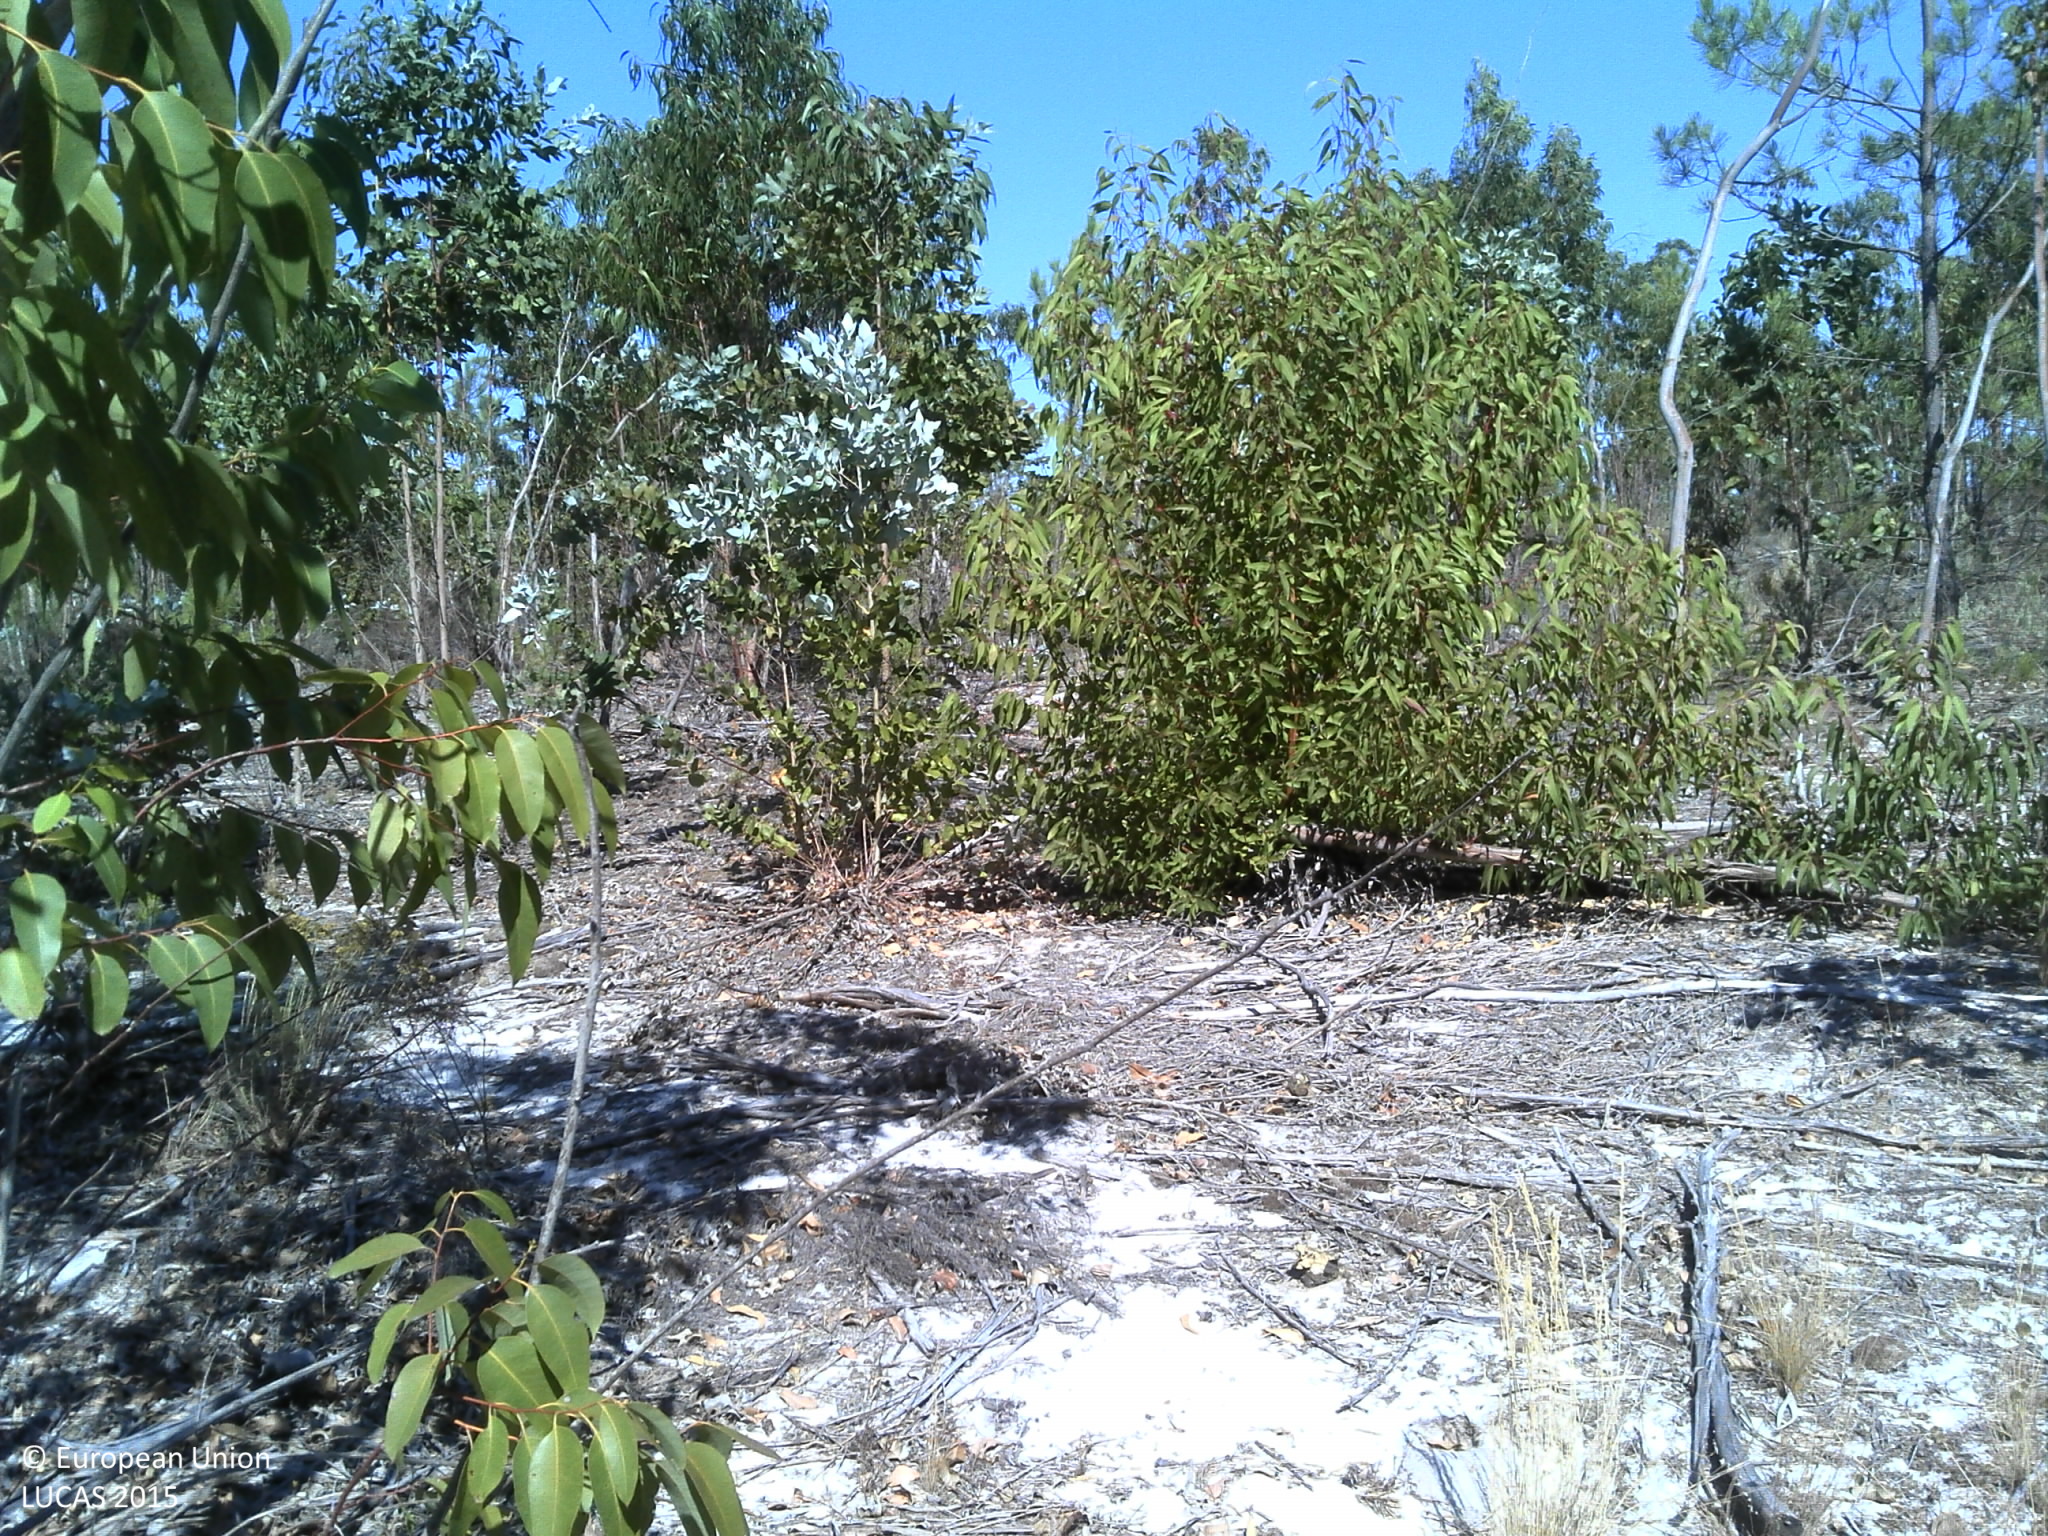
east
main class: Woodland
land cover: Broadleaved woodland
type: exotic forest
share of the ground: 25 - 50 %
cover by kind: broadleaved forest trees 40 %, unconsolidated bare surface 35 %, shrubs 10 %, herbaceous plants 10 %, coniferous forest trees 5 %
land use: Forestry
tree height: > 5 m
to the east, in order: Broadleaved woodland; Tracks; Broadleaved woodland
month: July
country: PT
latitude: 38.3108
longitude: -8.6607
